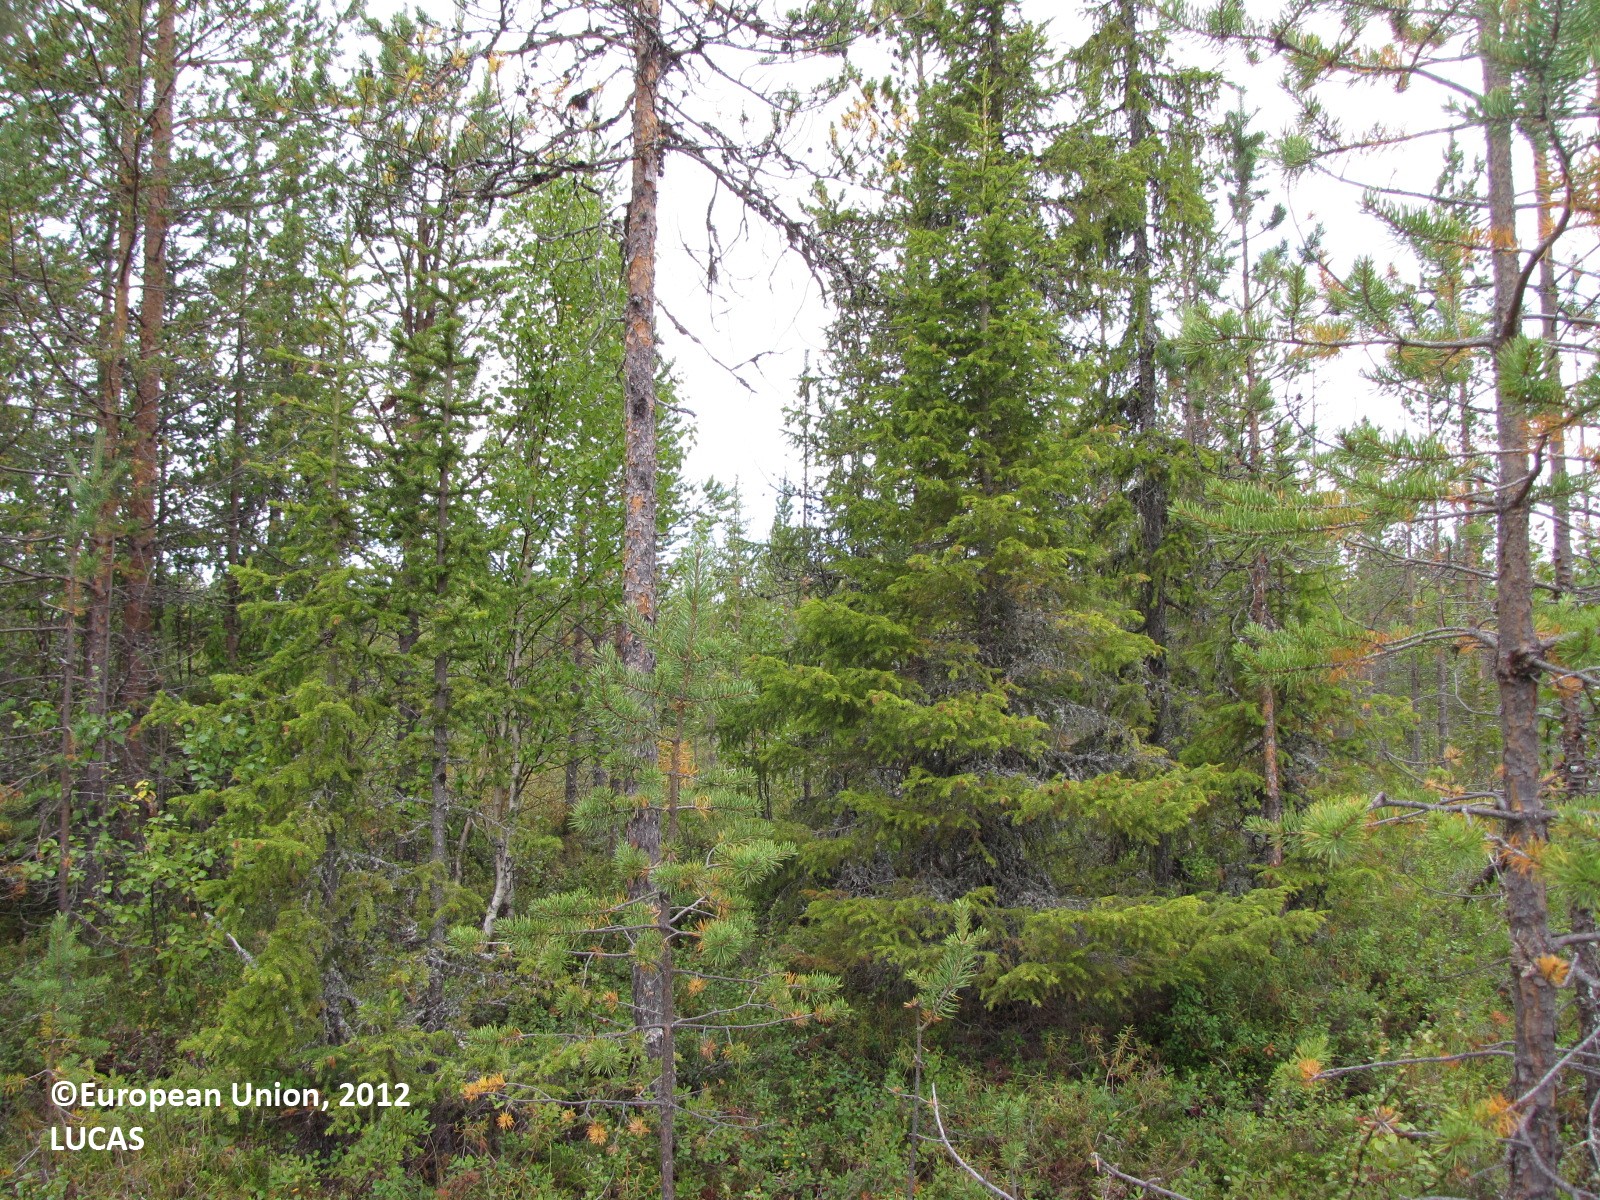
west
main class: Woodland
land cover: Other coniferous woodland
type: boreal forest
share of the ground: 25 - 50 %
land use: Forestry
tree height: > 5 m
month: August
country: FI
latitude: 67.1205
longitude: 25.1917
